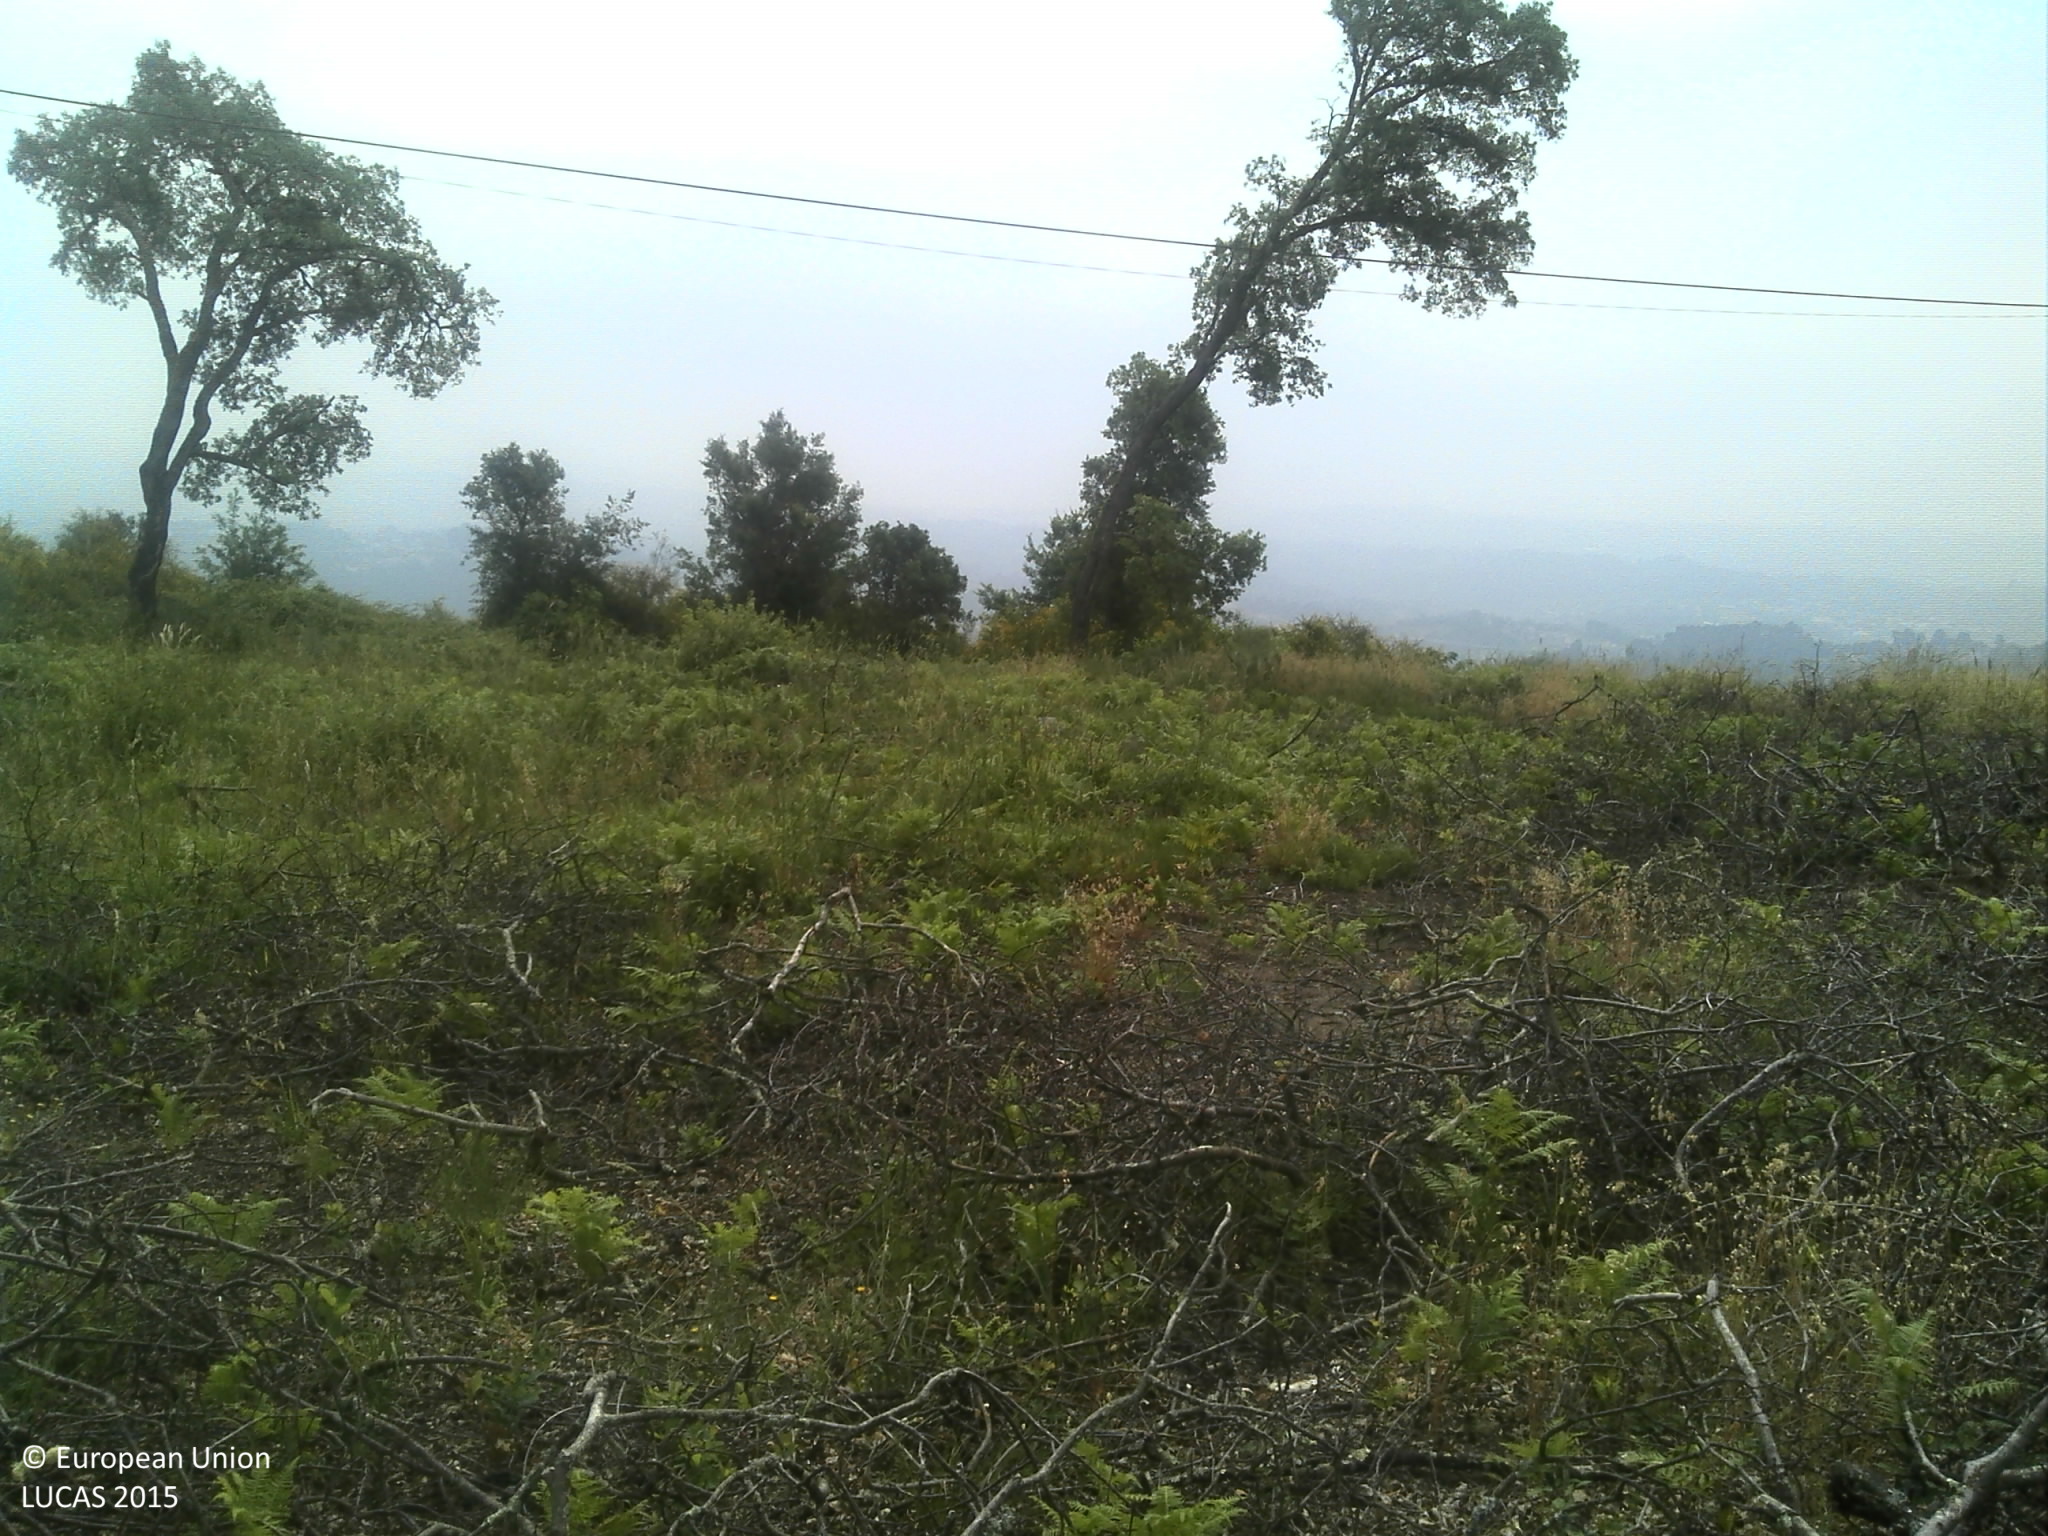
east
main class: Shrubland
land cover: Shrubland without tree cover
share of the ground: 50 - 75 %
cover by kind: shrubs 70 %, herbaceous plants 20 %, consolidated bare surface 5 %, unconsolidated bare surface 5 %
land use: Forestry
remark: Clear cut
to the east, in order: Shrubland without tree cover; Electric lines; Shrubland without tree cover; Shrubland with sparse tree cover; Shrubland without tree cover; Electric lines; Paved roads, cycling and walking lanes; Shrubland without tree cover; Artificial constructions in urban areas; Shrubland without tree cover; Shrubland with sparse tree cover; Broadleaved woodland; Vineyards; Shrubland without tree cover; Abandoned hedges; Shrubland without tree cover; Broadleaved woodland
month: June
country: PT
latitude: 41.3482
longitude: -8.2521
